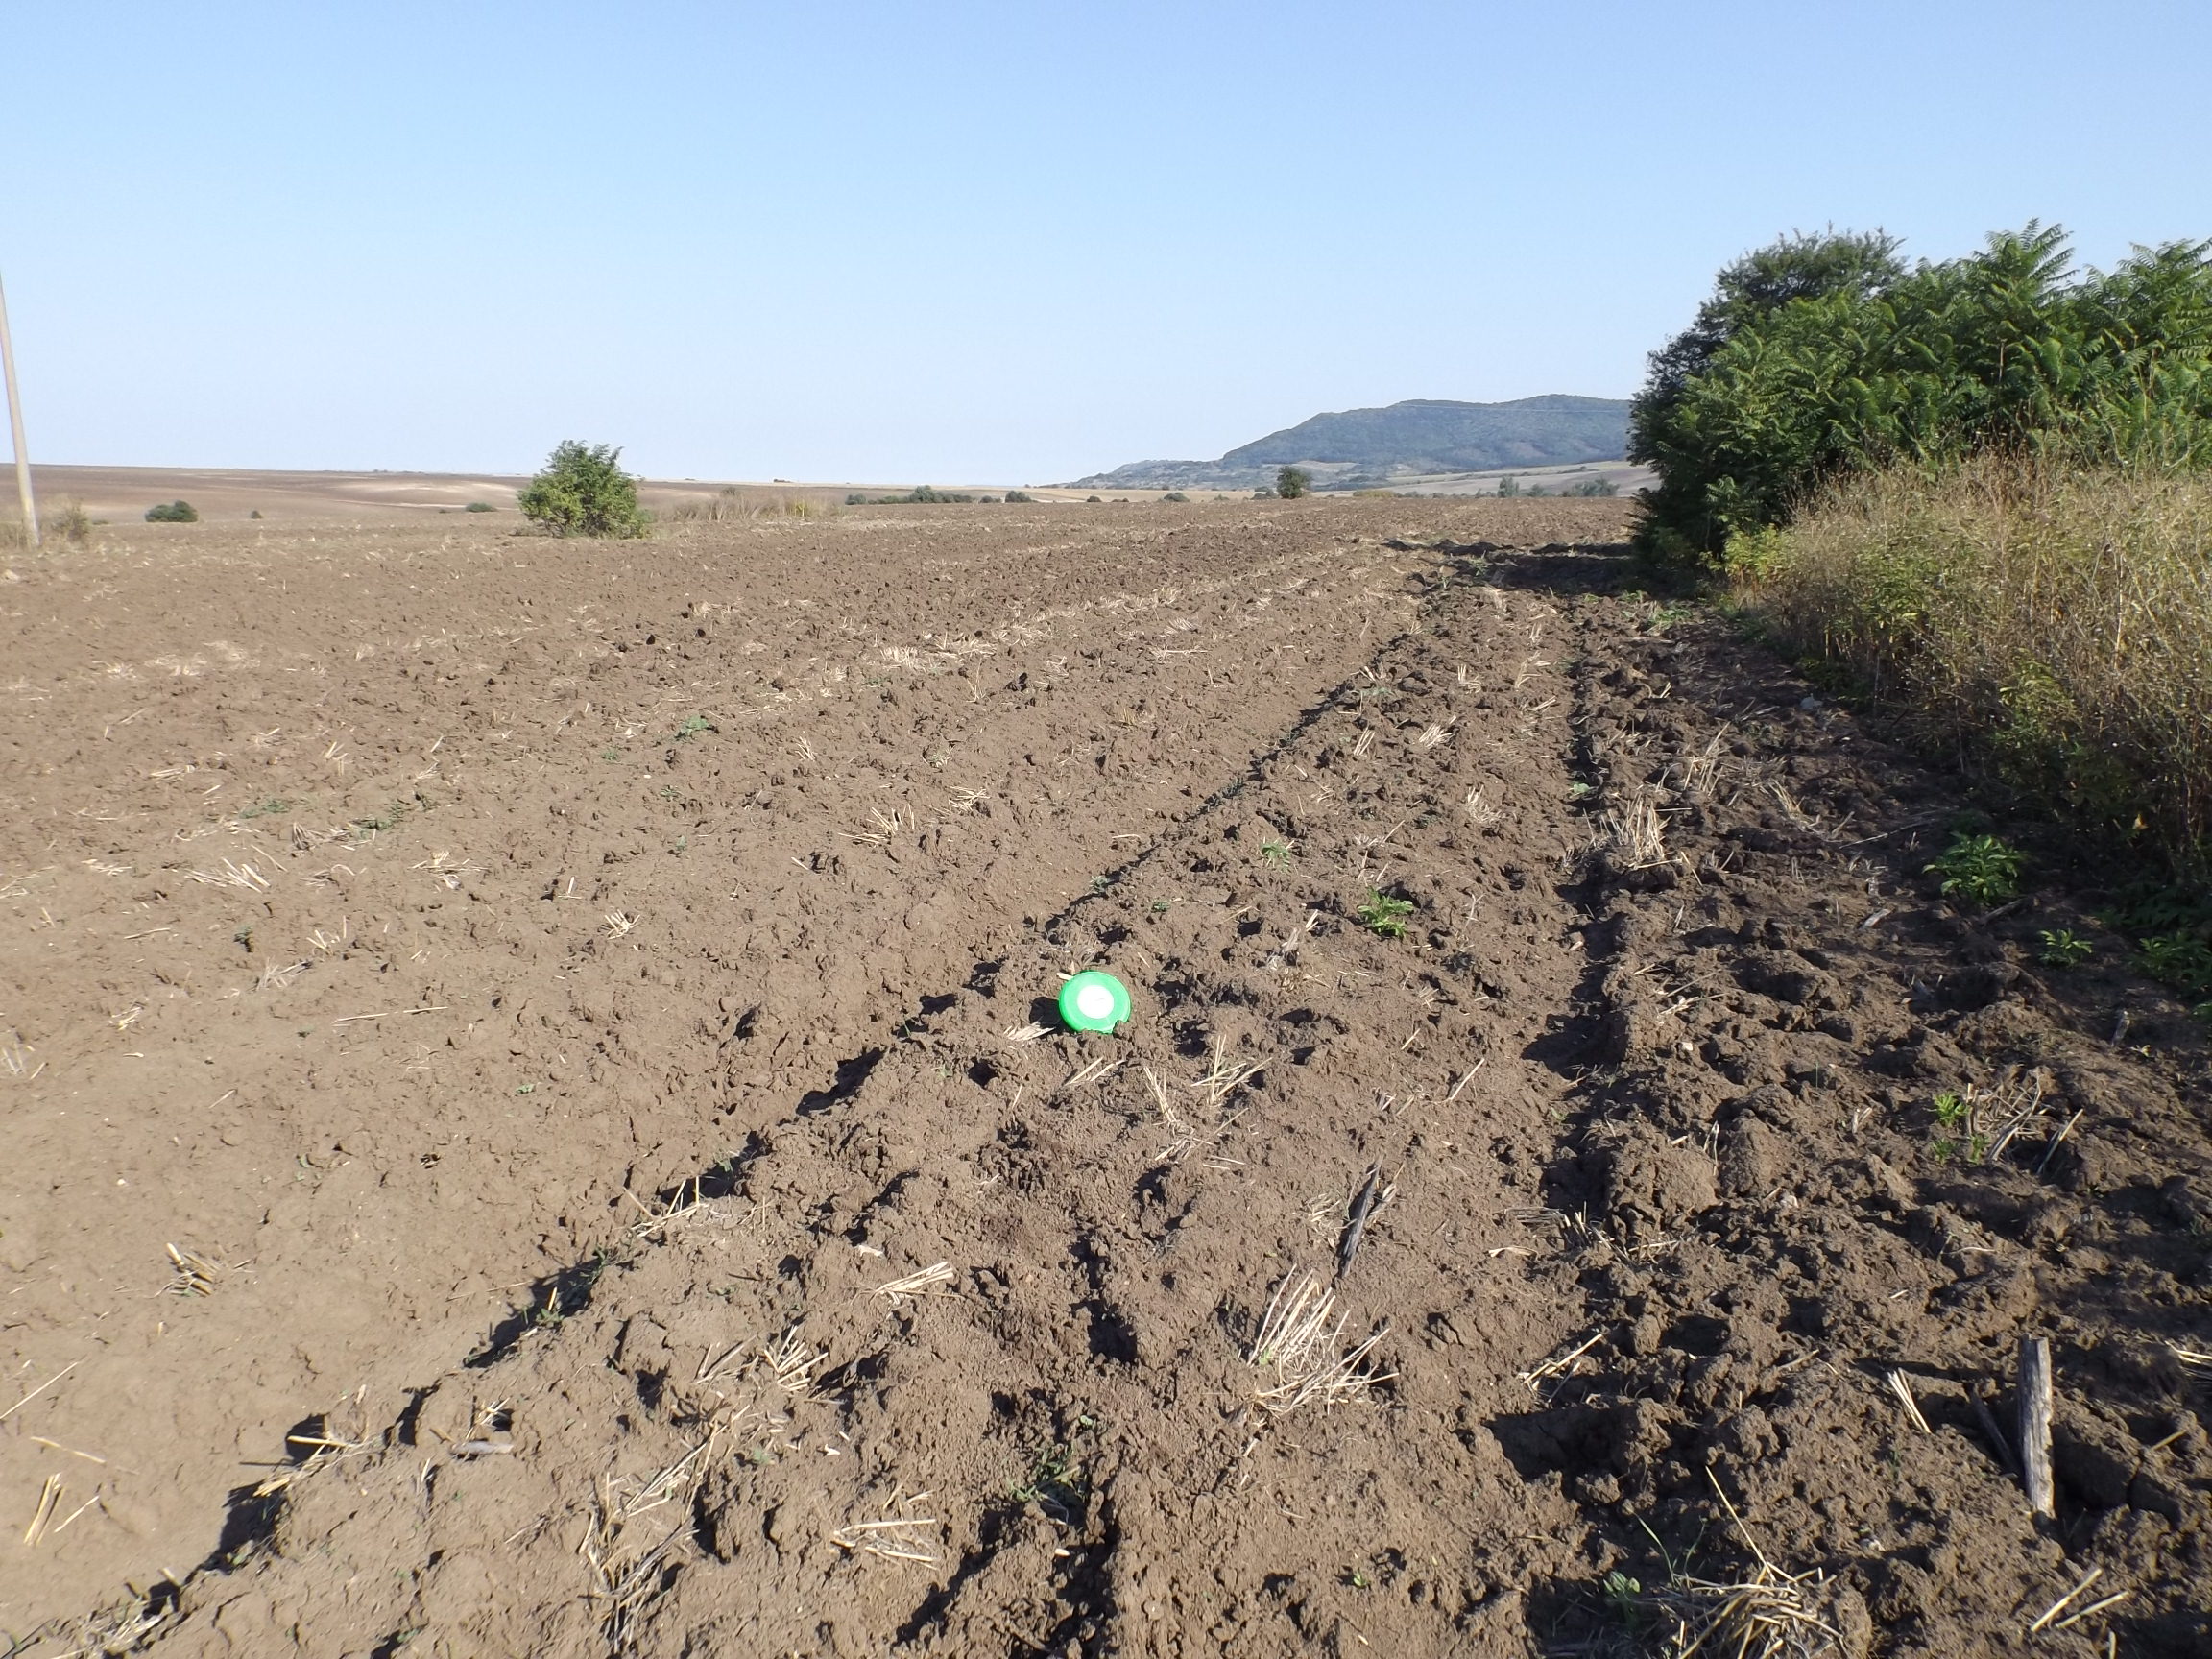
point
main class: Cropland
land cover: Common wheat
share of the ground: < 10 %
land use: Agriculture (excluding fallow land and kitchen gardens)
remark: Harvested field
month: August
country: BG
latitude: 43.1257
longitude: 27.3933
